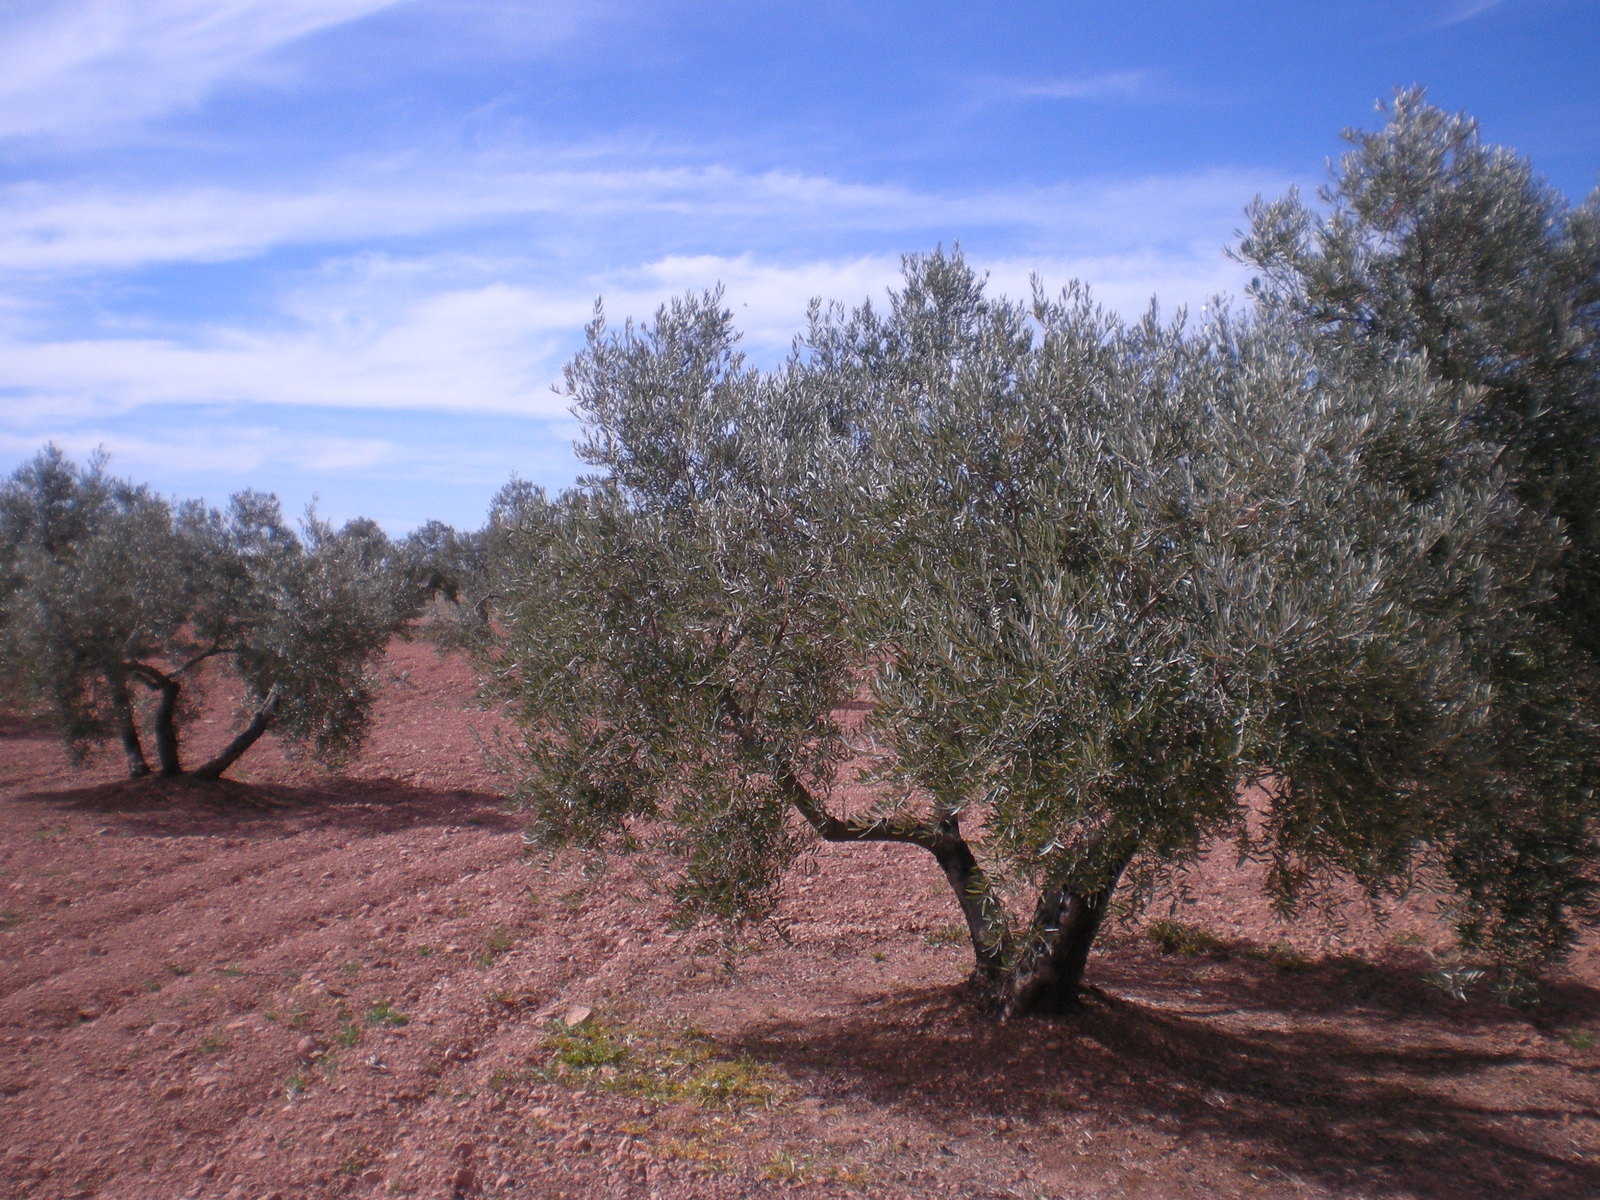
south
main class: Cropland
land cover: Olive groves
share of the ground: 10 - 25 %
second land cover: Other bare soil
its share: > 75 %
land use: Agriculture (excluding fallow land and kitchen gardens)
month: March
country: ES
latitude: 38.9824
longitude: -3.2301
